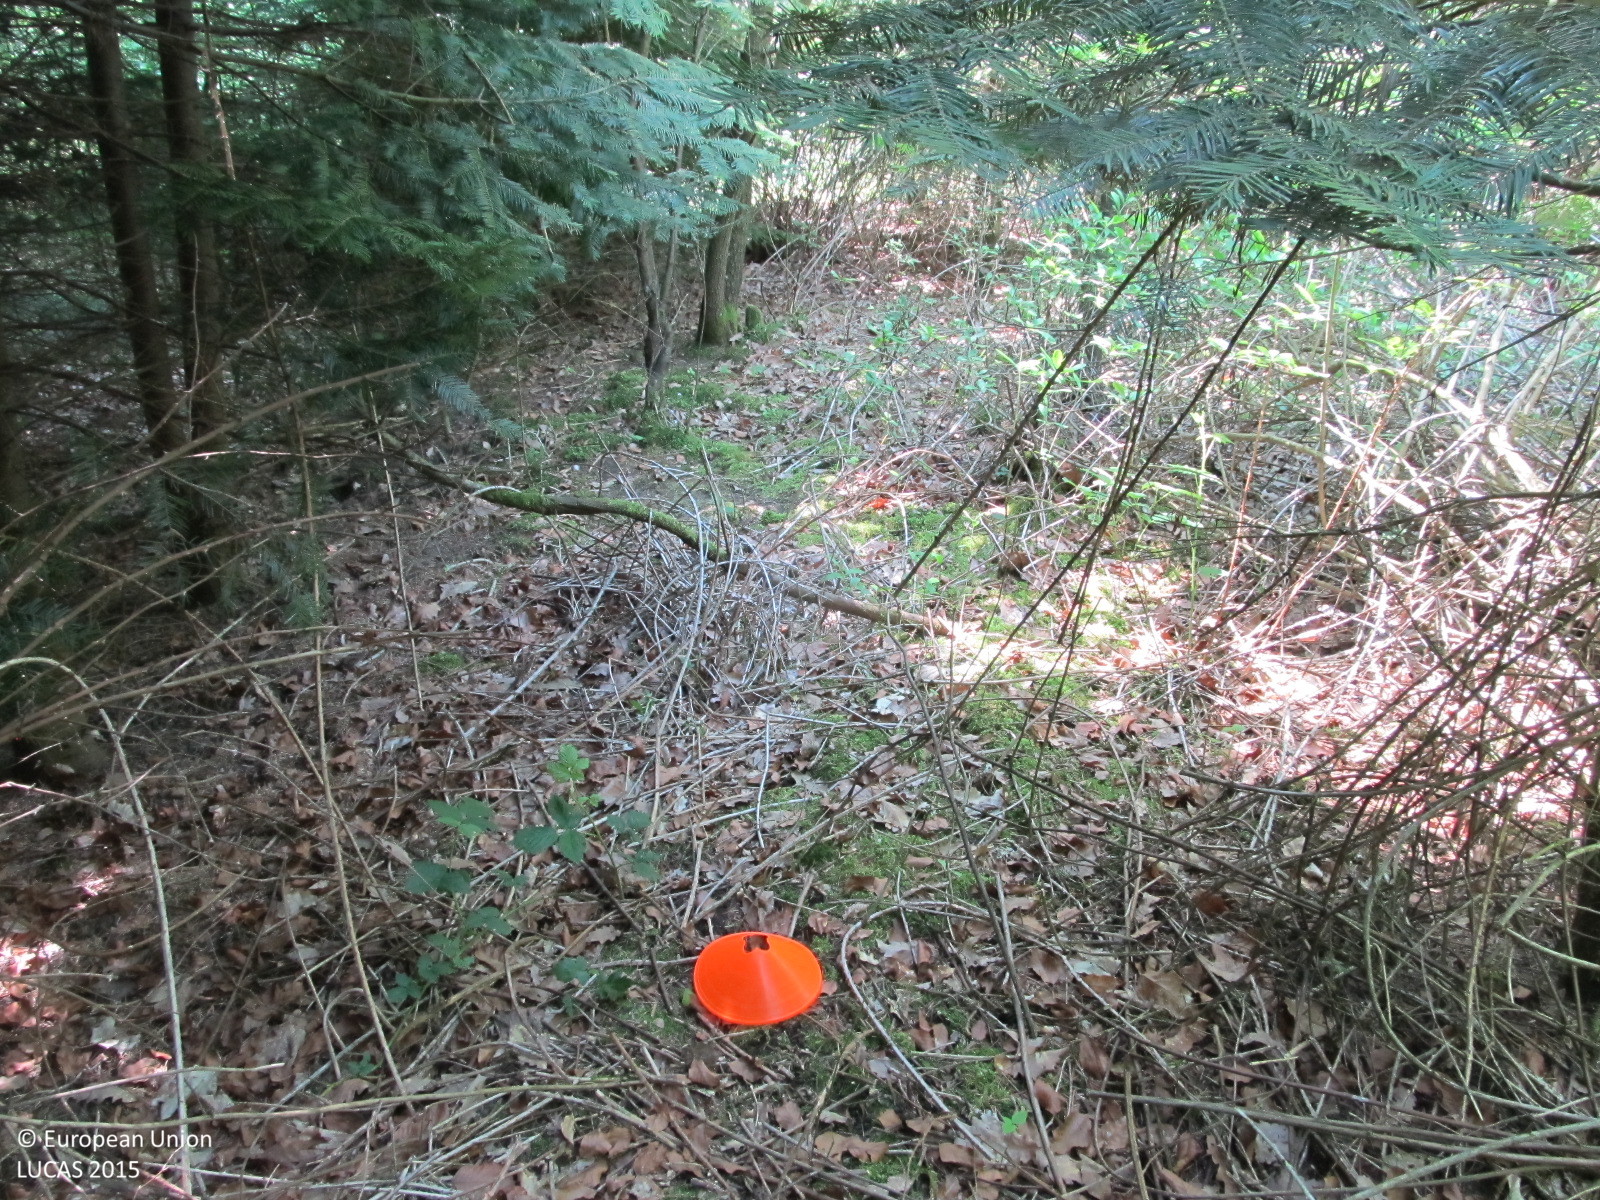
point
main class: Woodland
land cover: Other mixed woodland
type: hemiboreal forest and nemoral coniferous forest and mixed broadleaved-coniferous forest
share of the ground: > 75 %
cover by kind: coniferous forest trees 50 %, broadleaved forest trees 30 %, shrubs 10 %, herbaceous plants 10 %
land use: Forestry
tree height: > 5 m
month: May
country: AT
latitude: 48.6910
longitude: 15.6684
